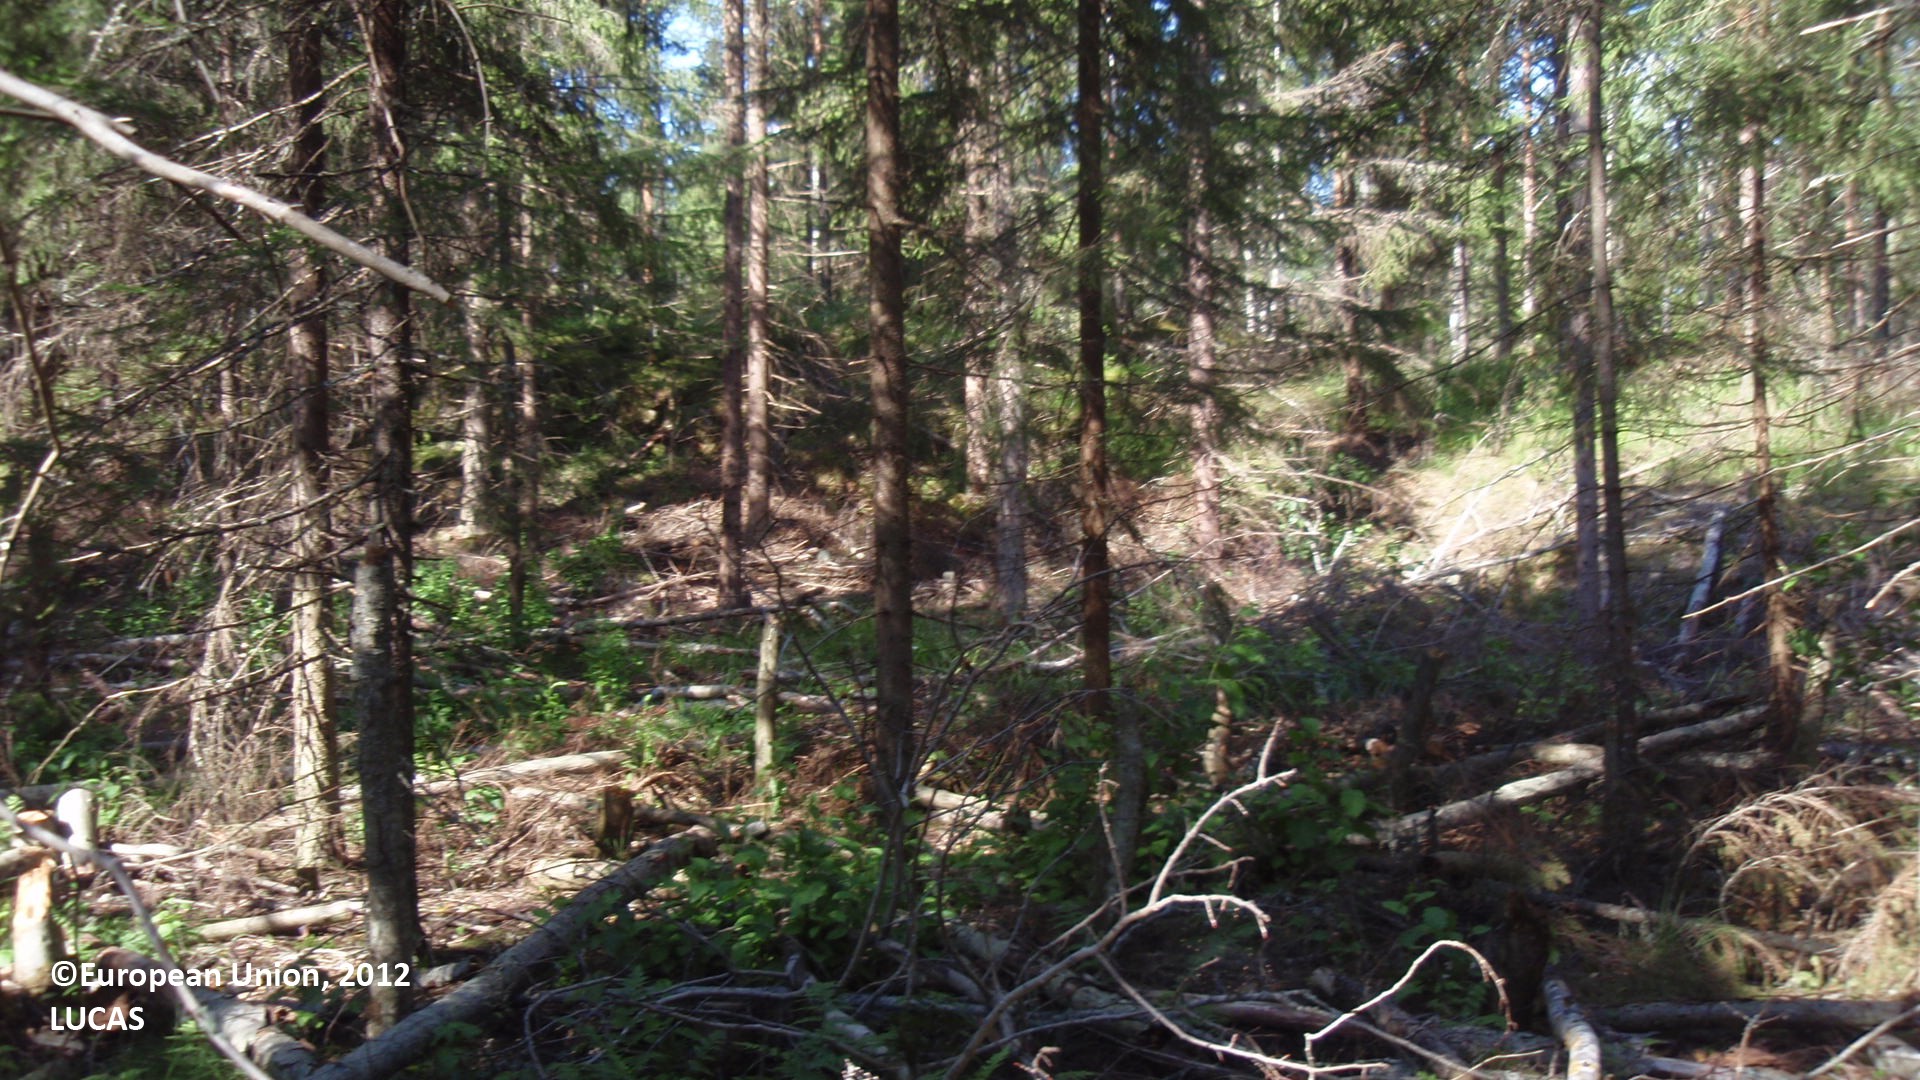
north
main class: Woodland
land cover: Spruce dominated mixed woodland
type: boreal forest
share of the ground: 25 - 50 %
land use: Forestry
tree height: > 5 m
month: July
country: FI
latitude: 61.1121
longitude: 28.2239
